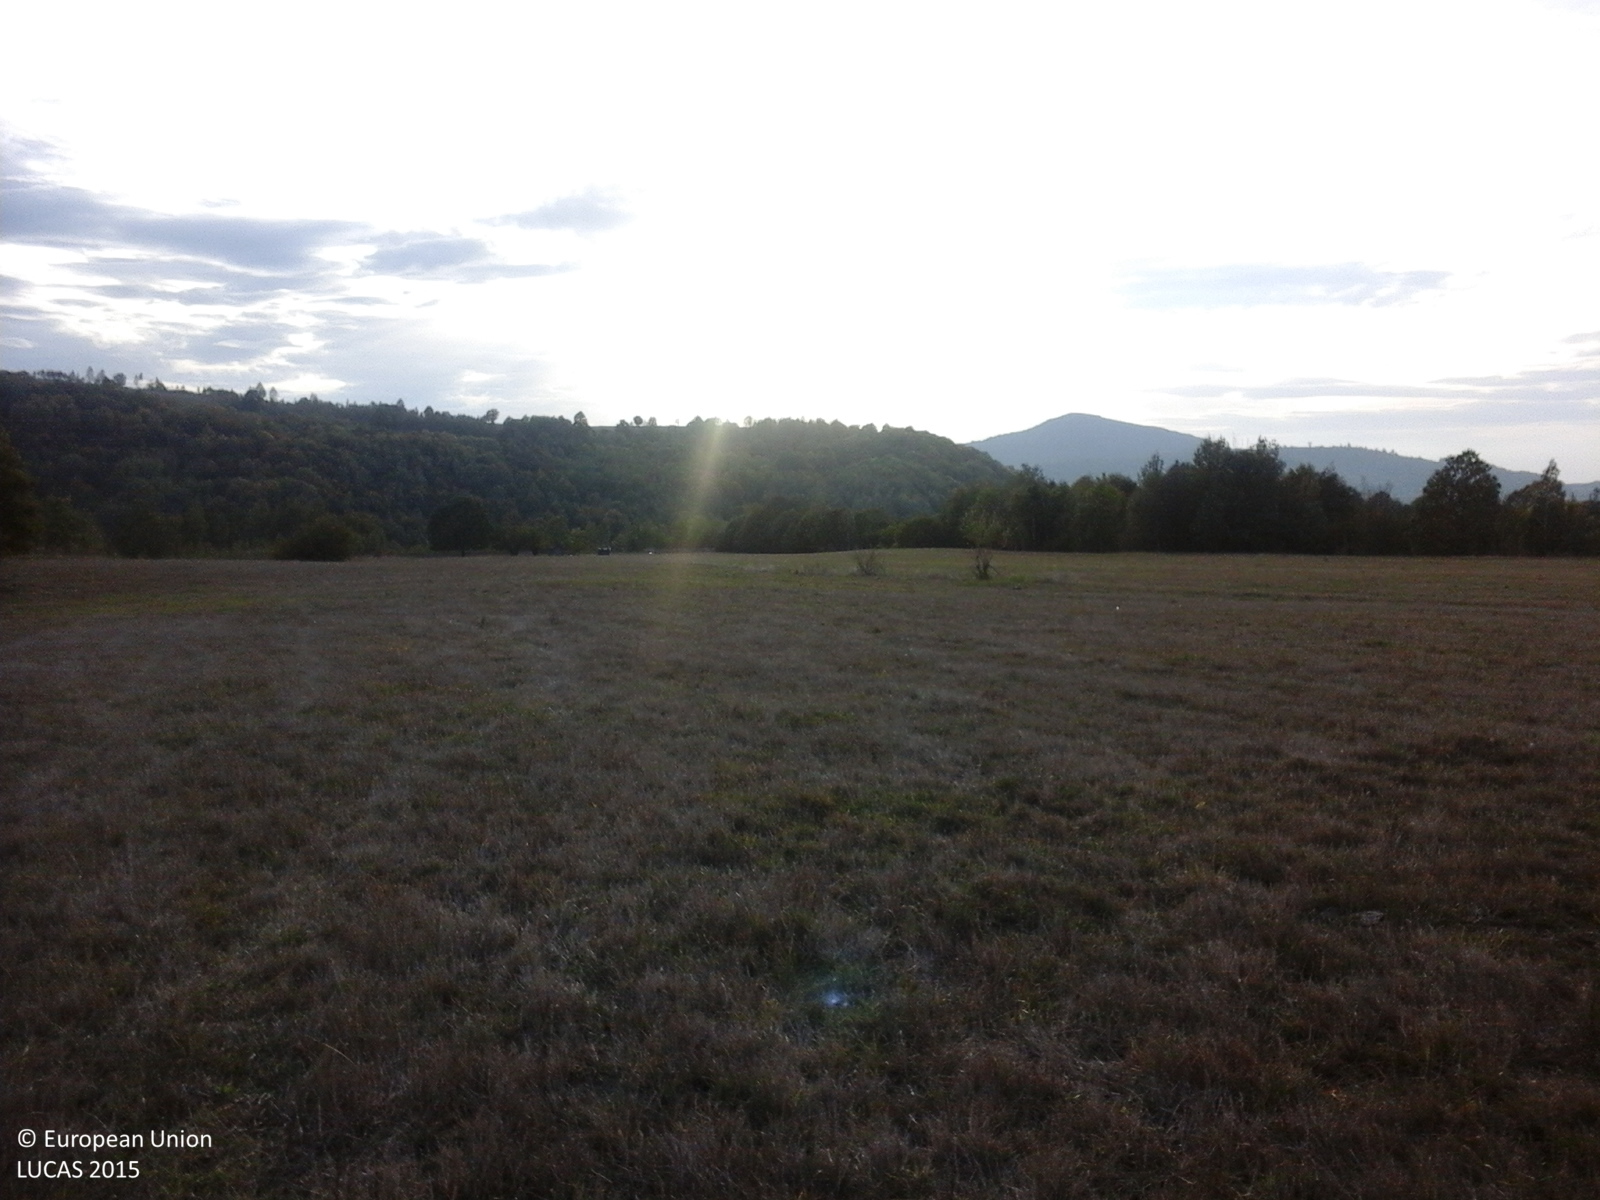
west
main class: Grassland
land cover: Grassland without tree/shrub cover
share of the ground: > 75 %
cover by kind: herbaceous plants 100 %
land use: Agriculture (excluding fallow land and kitchen gardens)
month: October
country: RO
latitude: 46.0906
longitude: 25.8808
